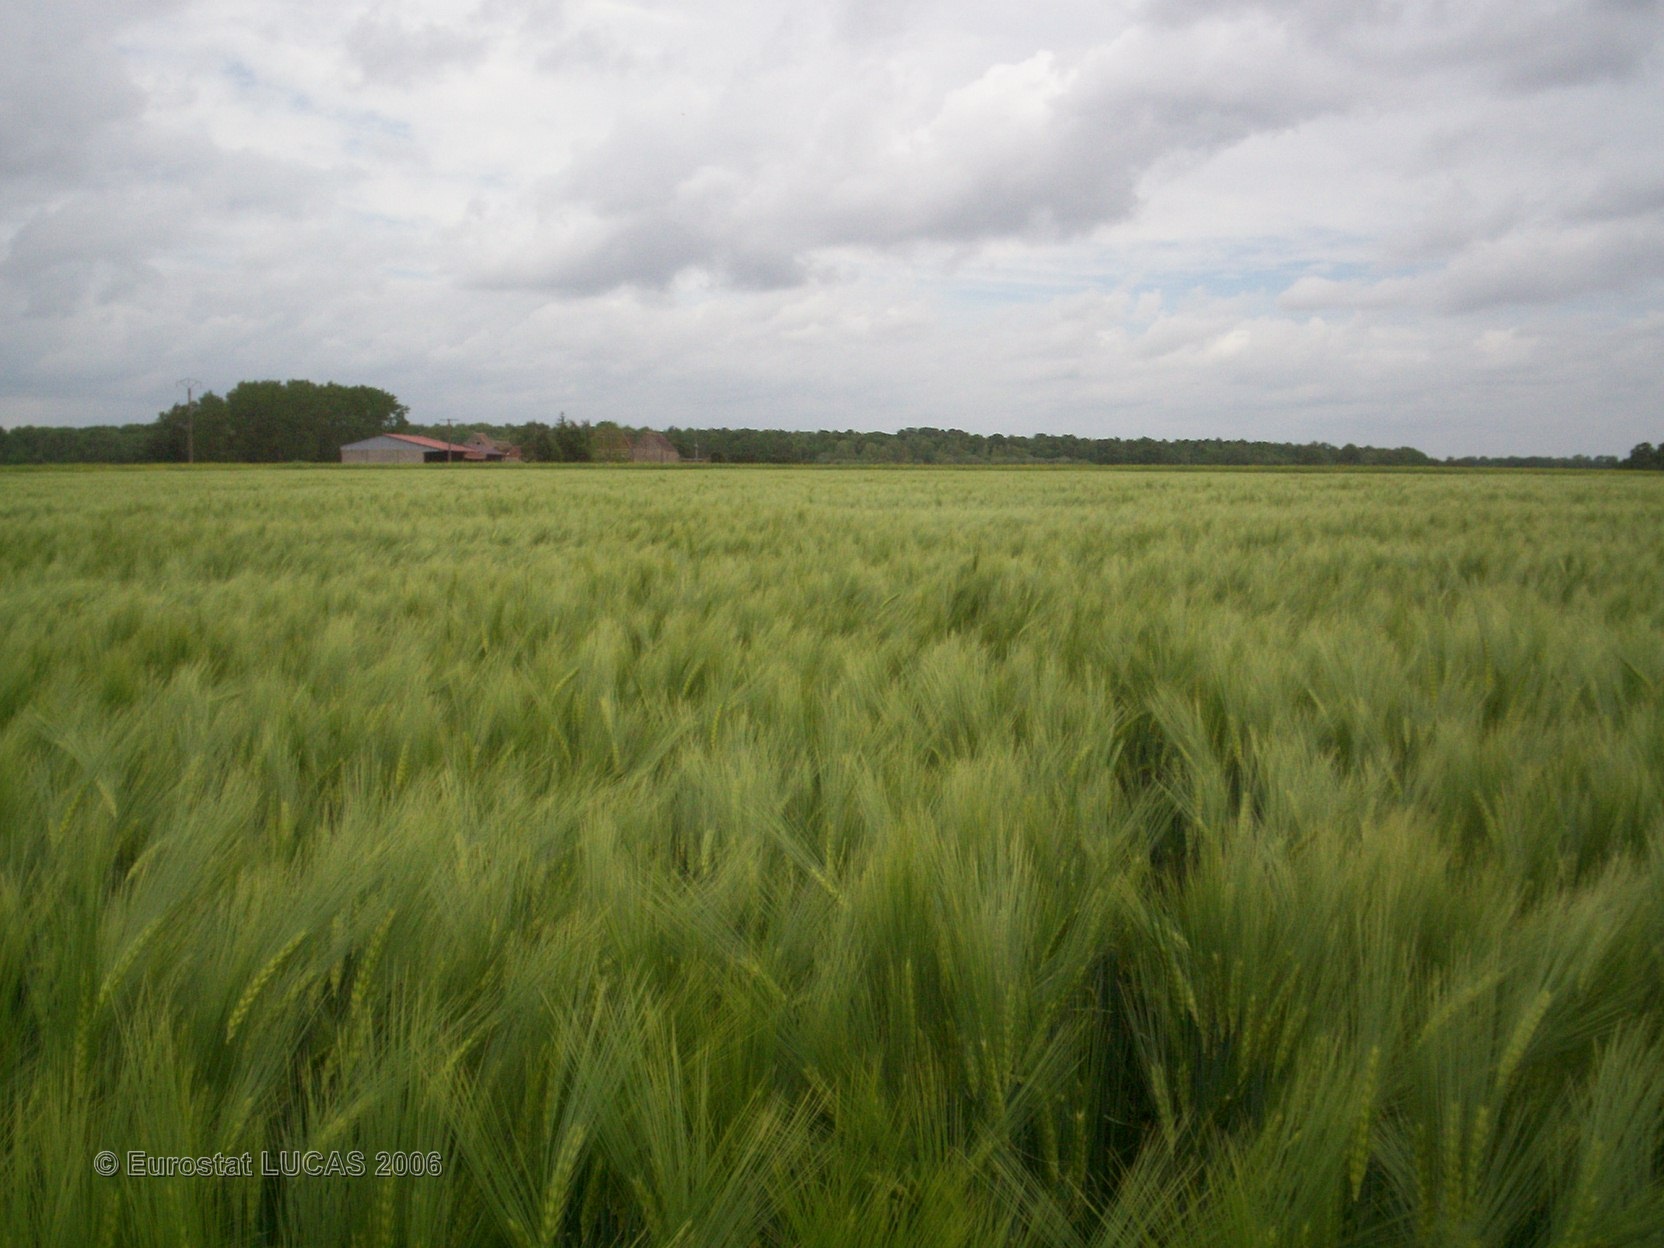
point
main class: Cropland
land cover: Common wheat
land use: Agriculture (excluding fallow land and kitchen gardens)
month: May
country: FR
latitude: 48.6945
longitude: 2.8310
